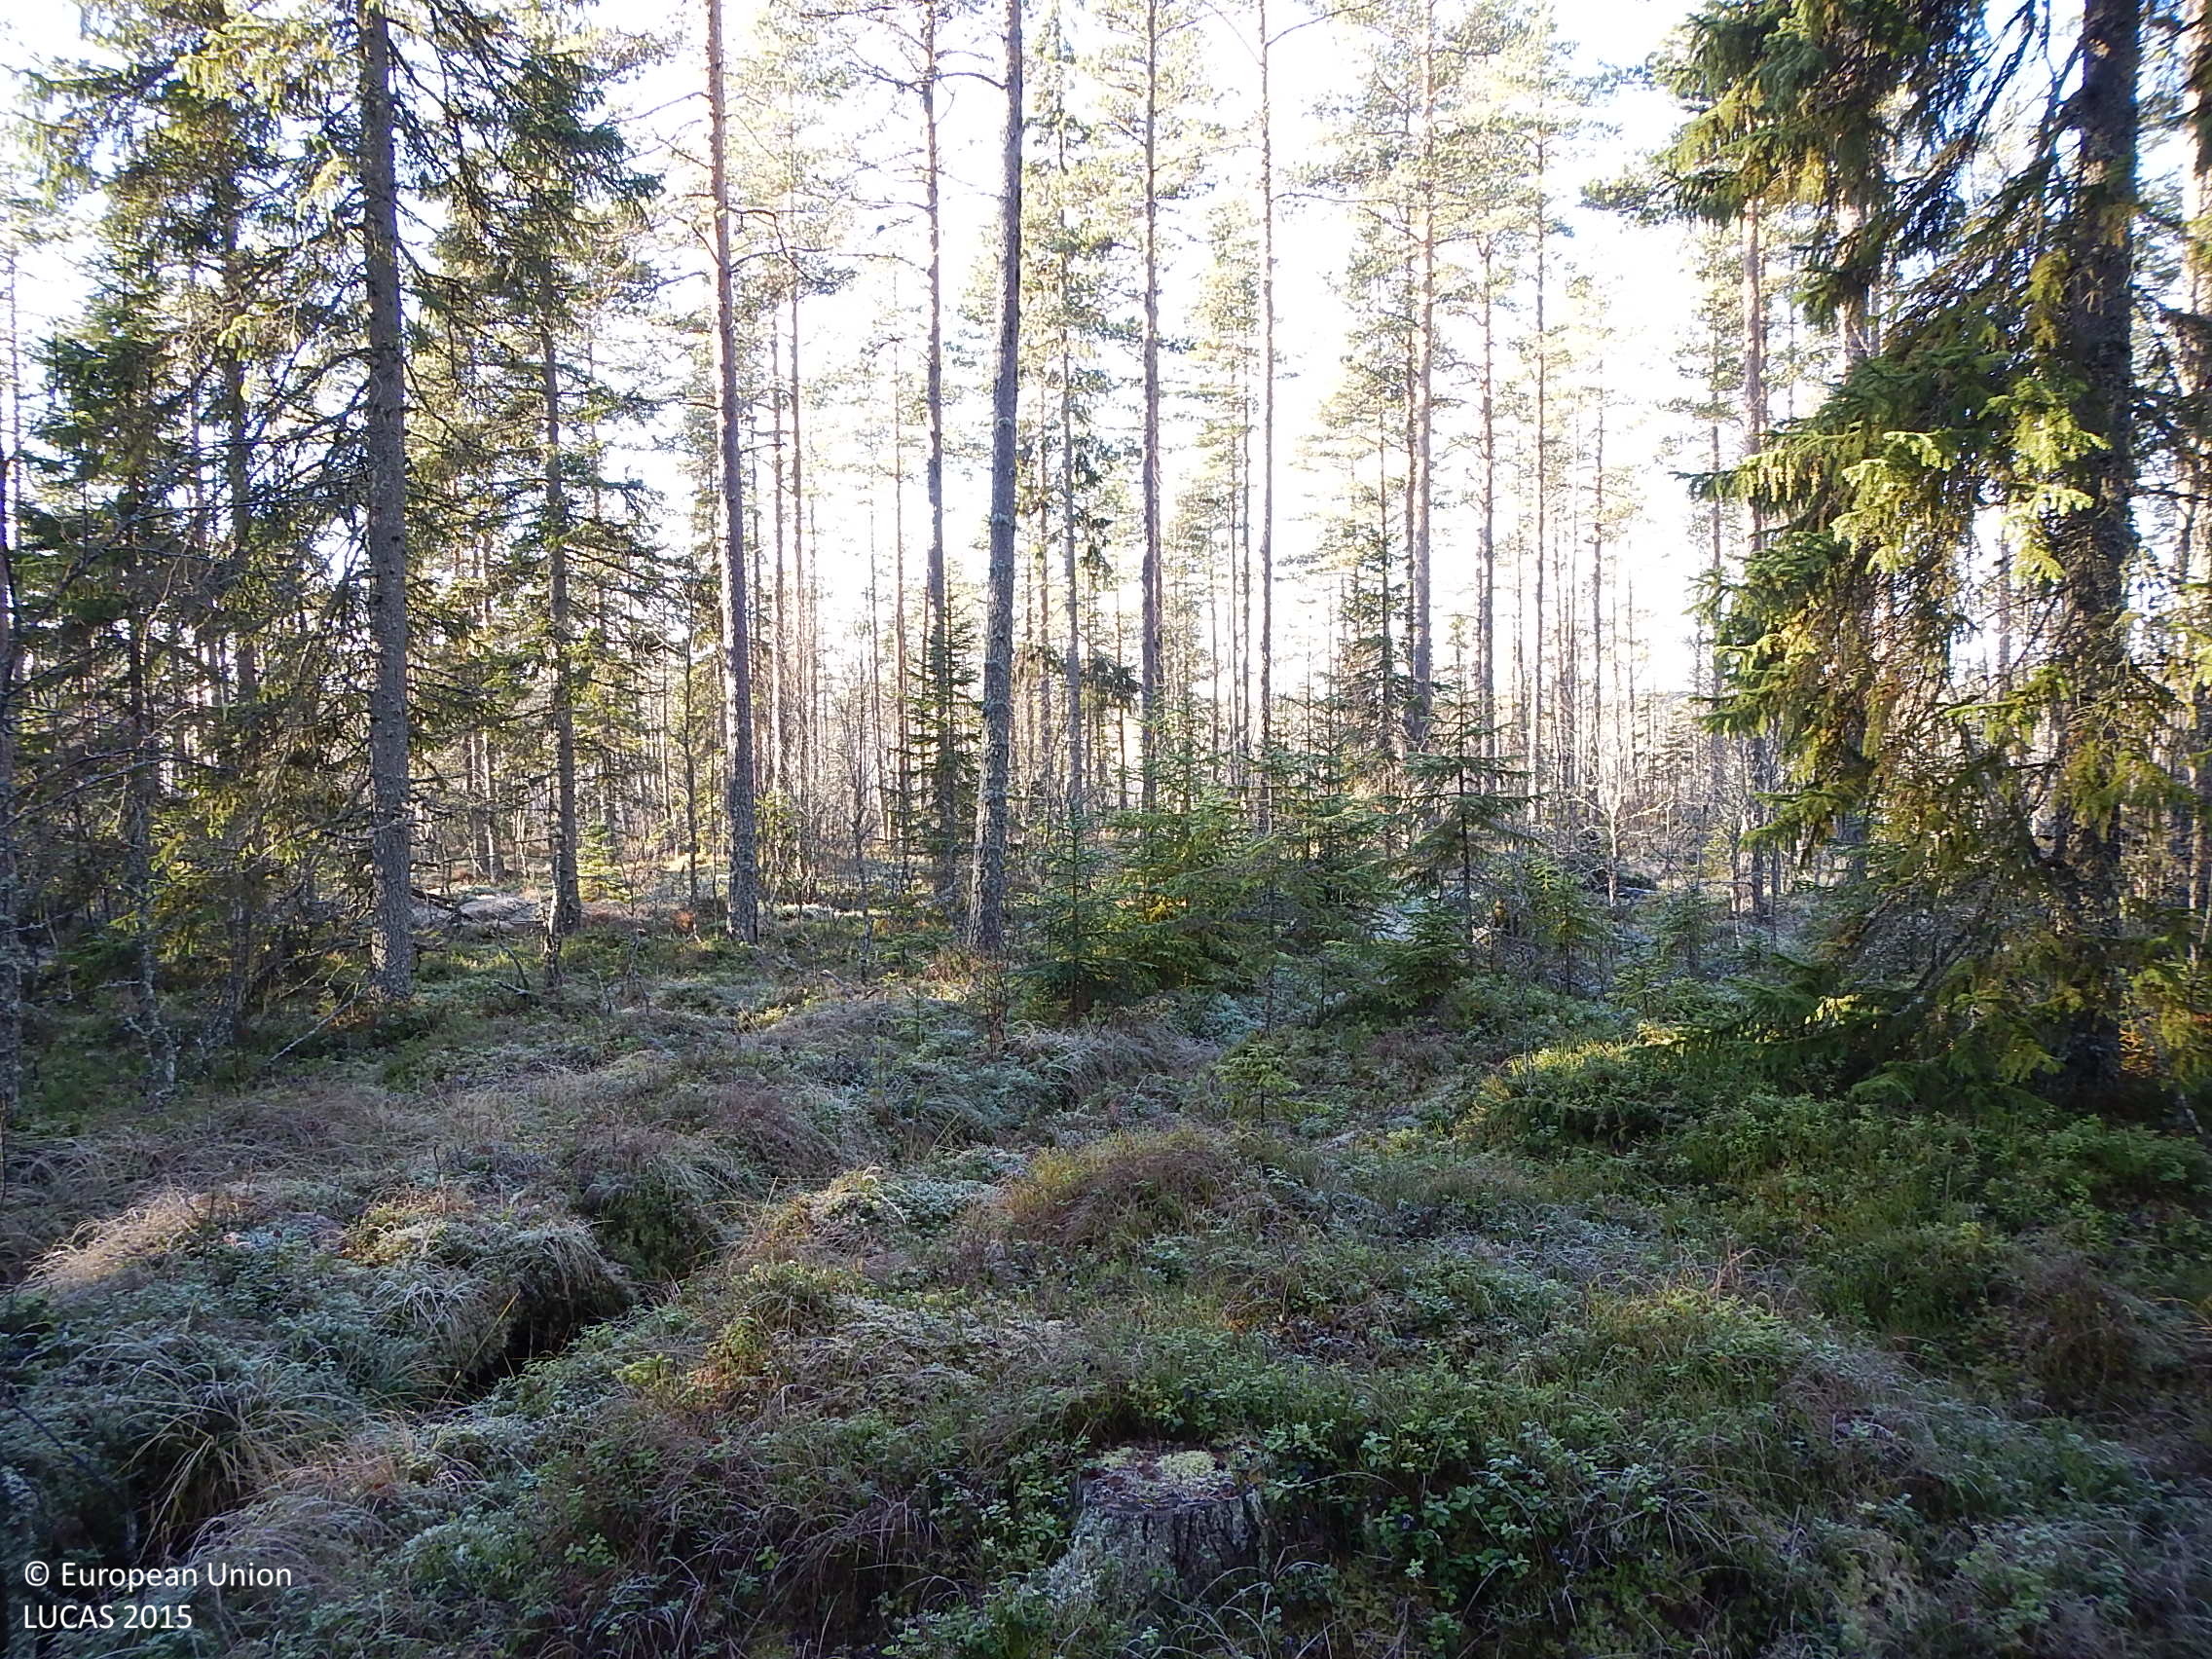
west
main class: Woodland
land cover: Pine dominated coniferous woodland
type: mire and swamp forests
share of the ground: 50 - 75 %
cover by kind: coniferous forest trees 60 %, shrubs 25 %, lichens and mosses 10 %, broadleaved forest trees 5 %
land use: Forestry
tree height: > 5 m
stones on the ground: < 10 %
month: November
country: SE
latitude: 61.5726
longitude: 15.9528
